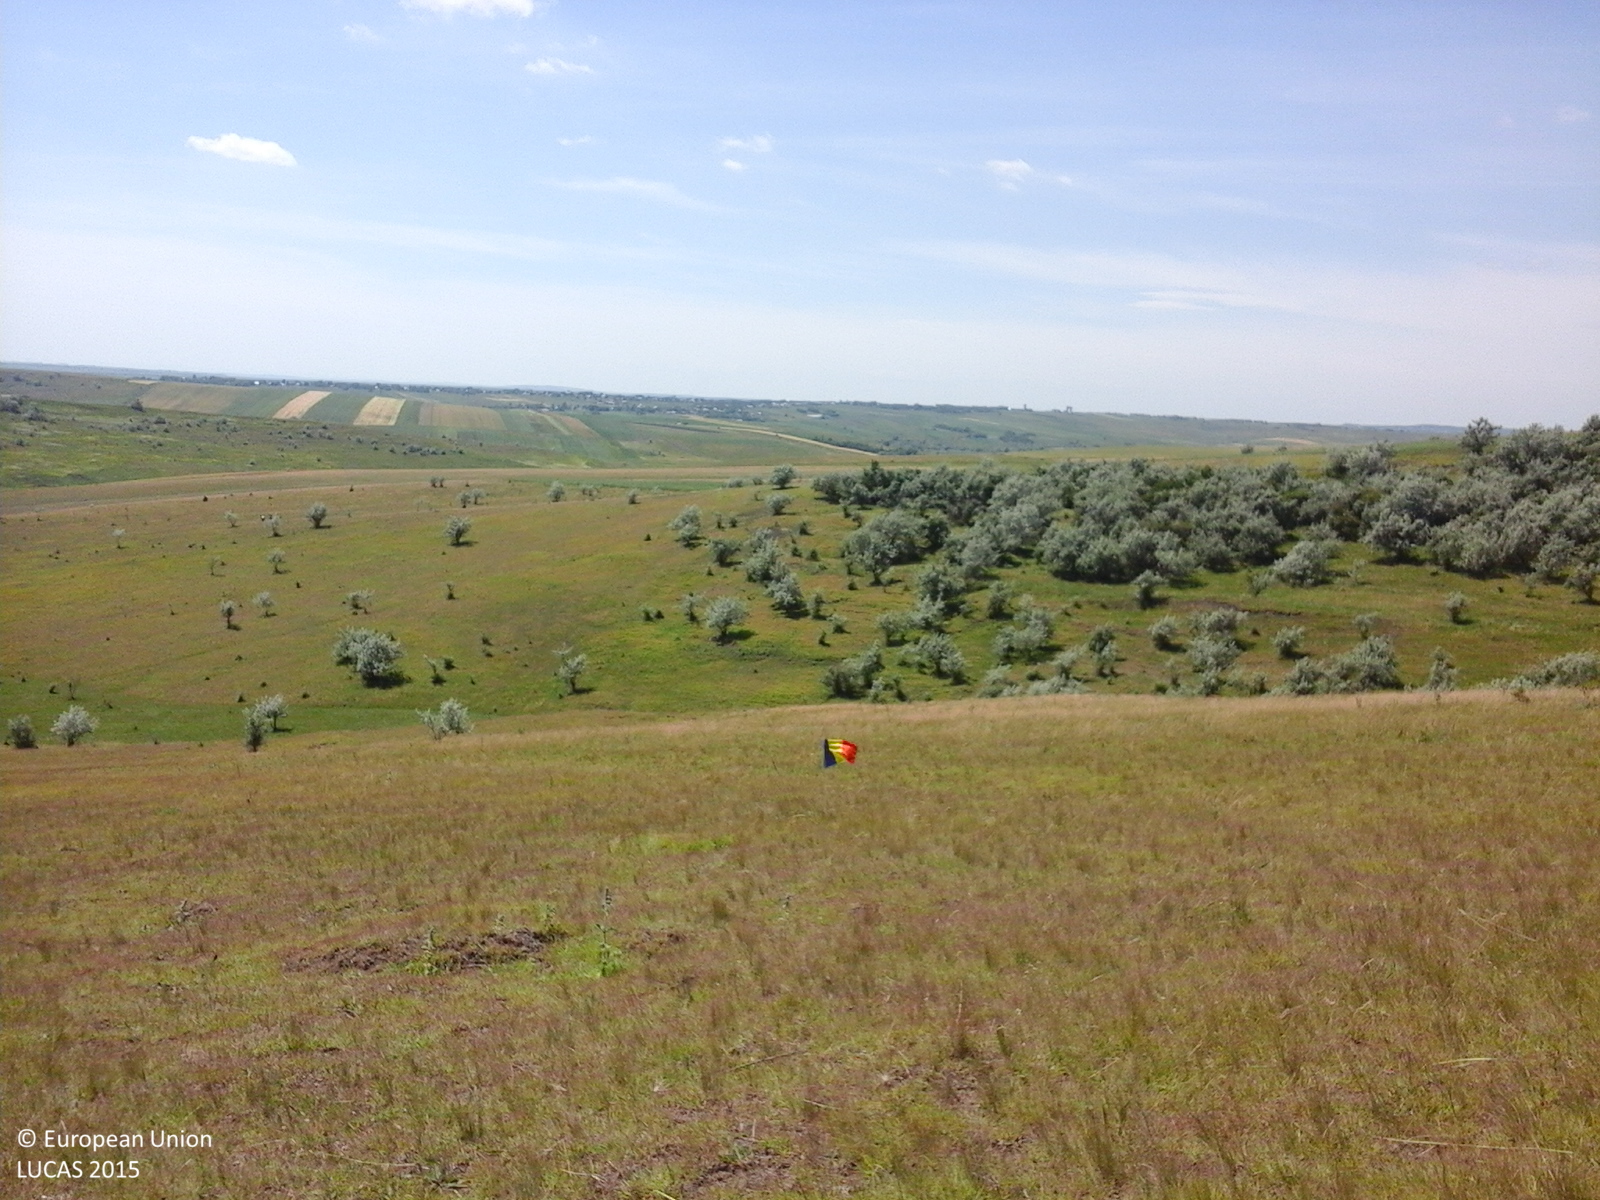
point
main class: Grassland
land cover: Grassland without tree/shrub cover
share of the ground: > 75 %
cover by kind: herbaceous plants 100 %
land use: Agriculture (excluding fallow land and kitchen gardens)
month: June
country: RO
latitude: 48.1463
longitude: 26.7252
